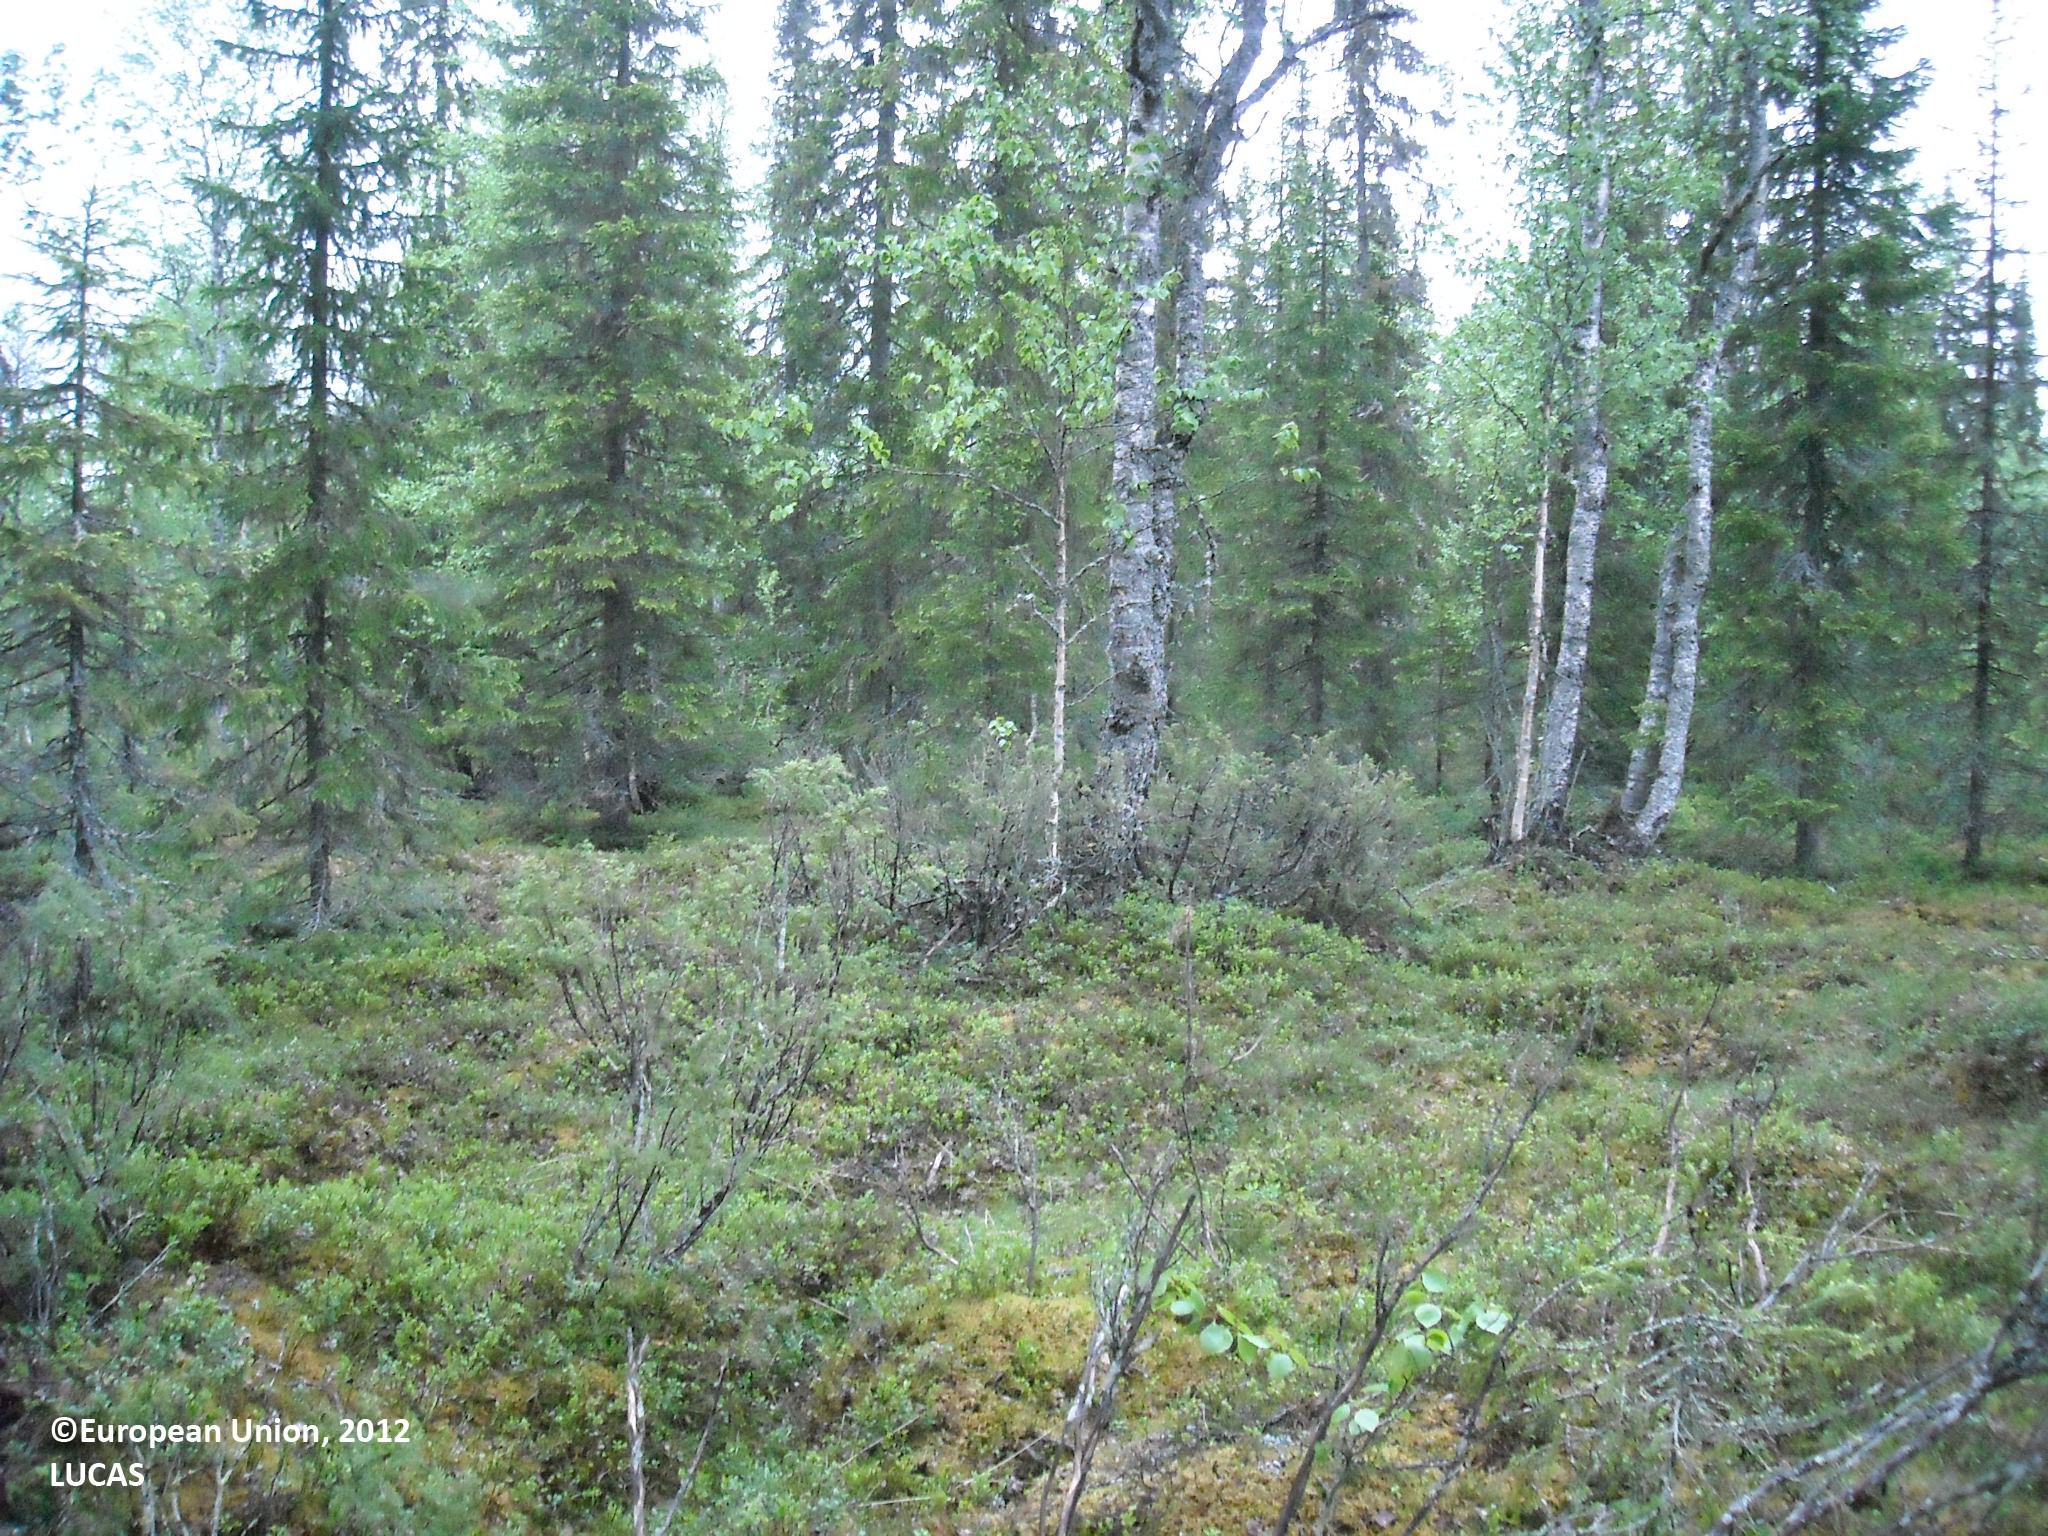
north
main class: Woodland
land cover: Spruce dominated mixed woodland
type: mire and swamp forests
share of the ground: 50 - 75 %
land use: Forestry
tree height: > 5 m
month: June
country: FI
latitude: 65.6290
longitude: 28.0178
